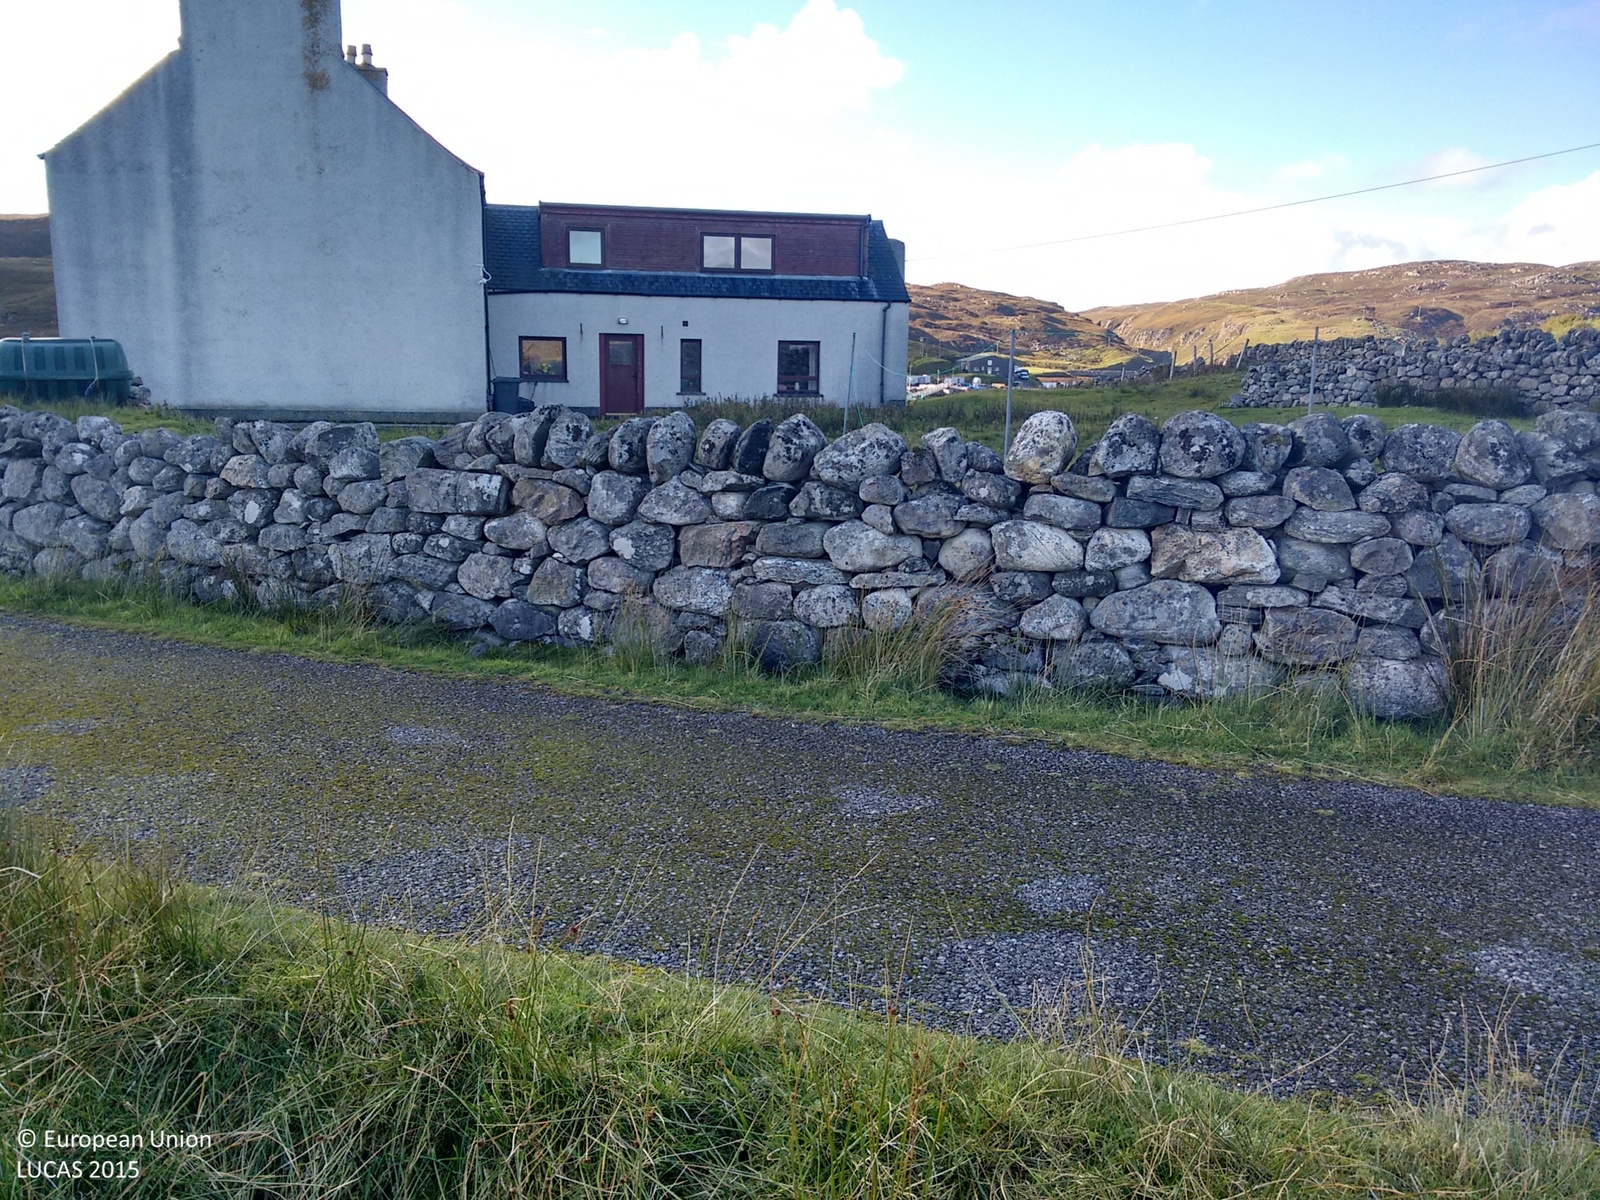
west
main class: Grassland
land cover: Grassland without tree/shrub cover
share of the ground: > 75 %
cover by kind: herbaceous plants 100 %
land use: Agriculture (excluding fallow land and kitchen gardens)
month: October
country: GB
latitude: 58.2012
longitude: -6.9452
